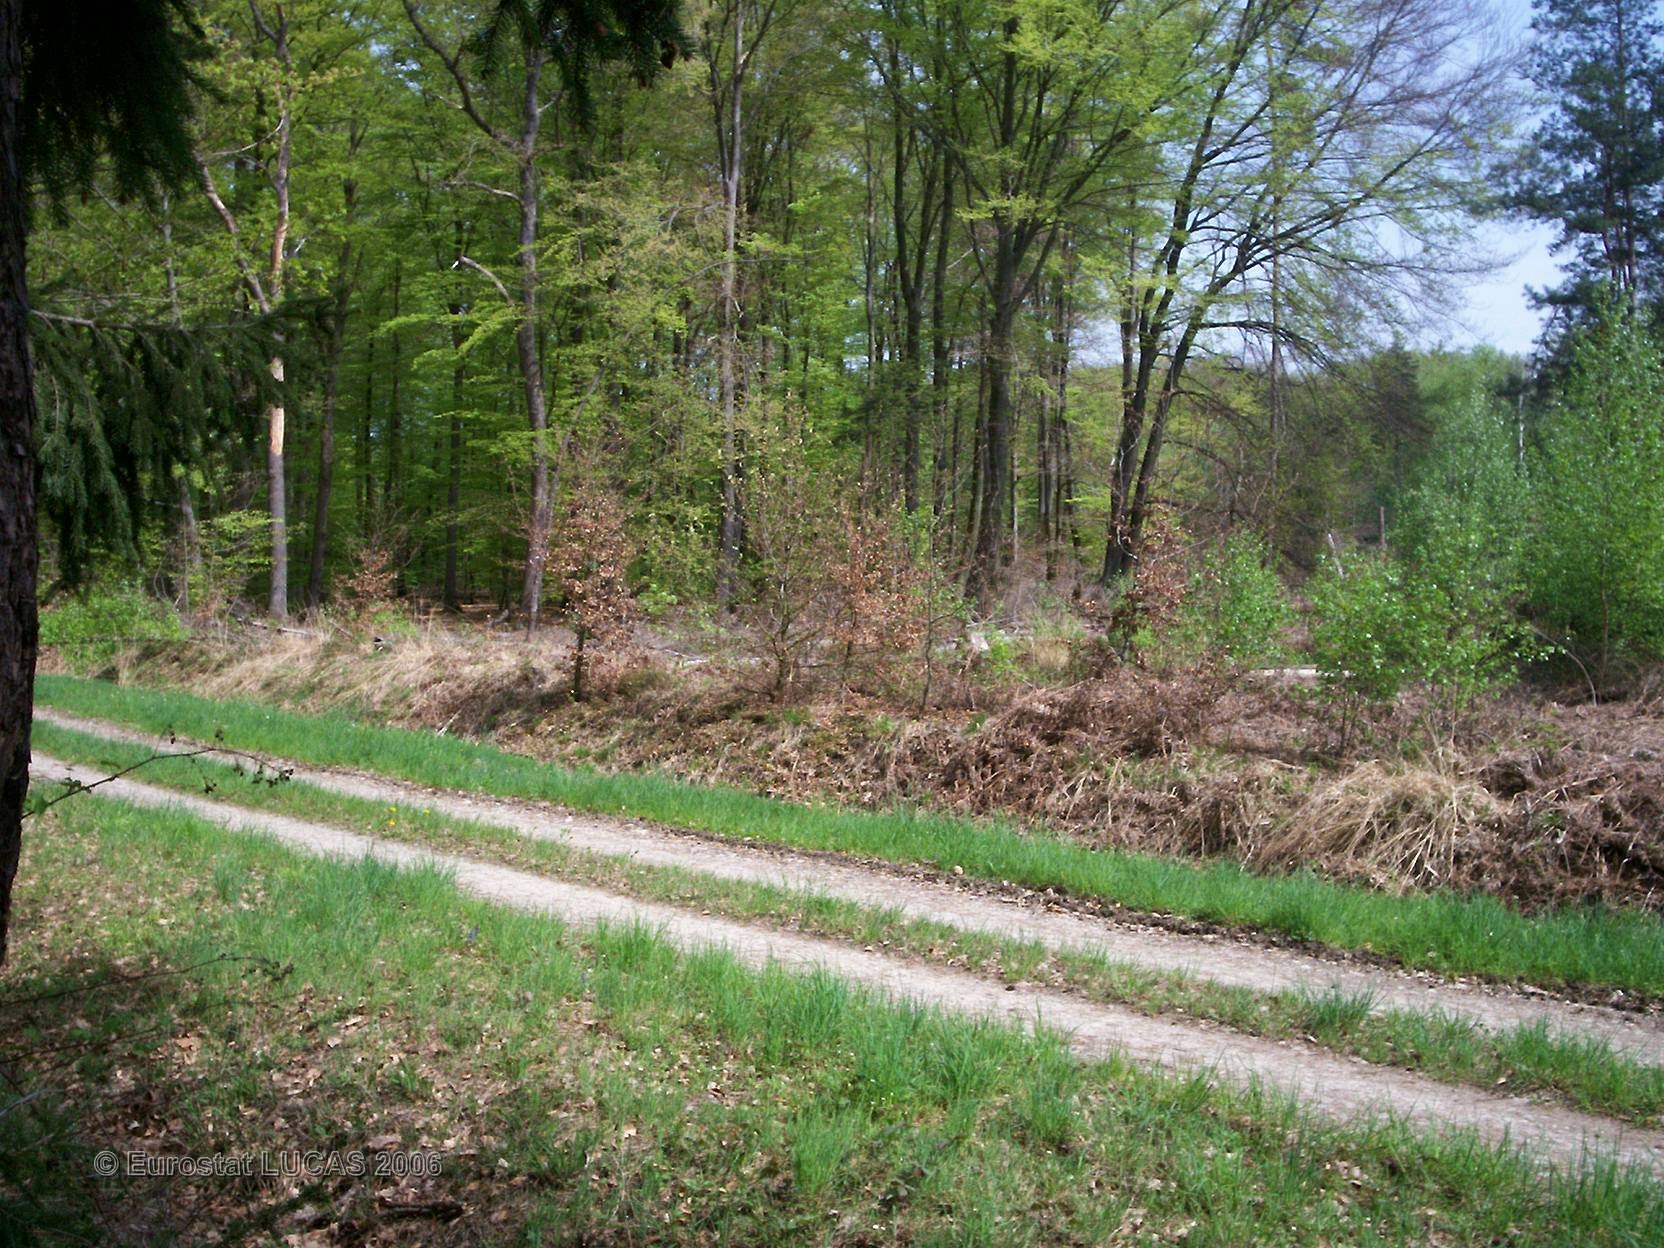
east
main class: Woodland
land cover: Mixed forest
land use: Forestry
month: May
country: FR
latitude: 48.9946
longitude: 7.0620
